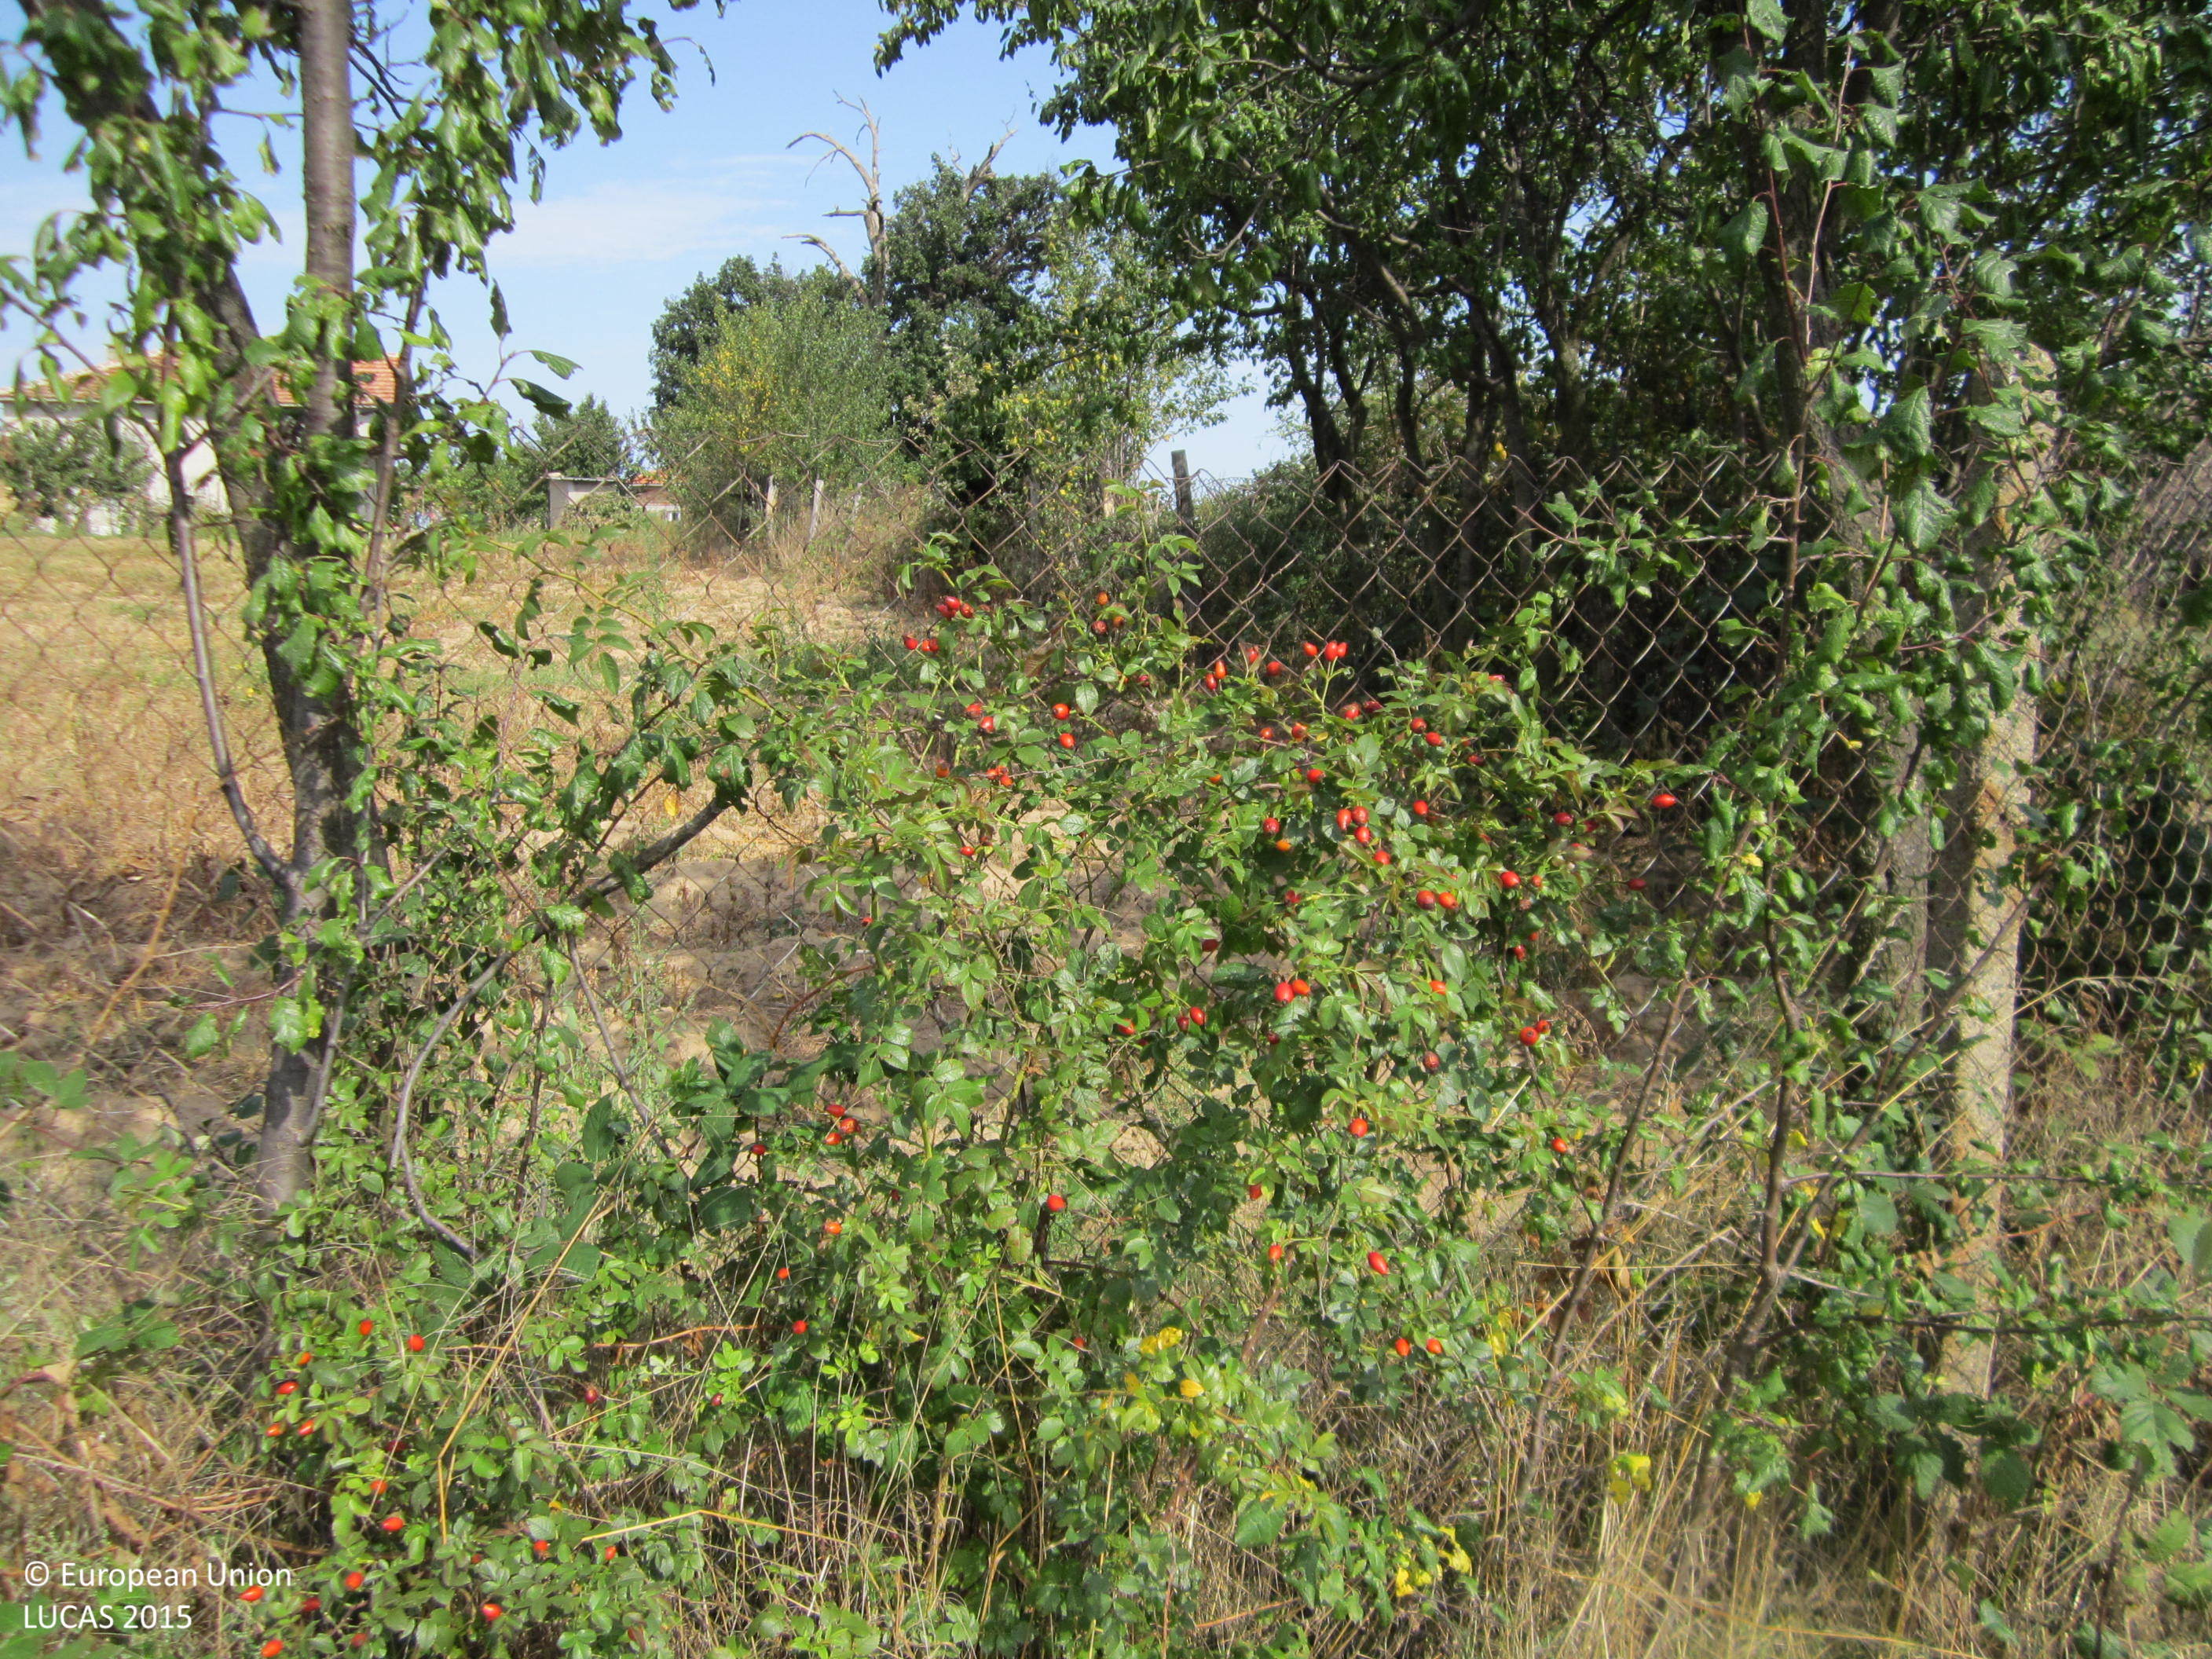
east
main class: Cropland
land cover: Potatoes
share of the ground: 25 - 50 %
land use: Kitchen garden
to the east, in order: Potatoes; Artificial constructions in urban areas
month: September
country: BG
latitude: 42.7785
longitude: 27.1635
